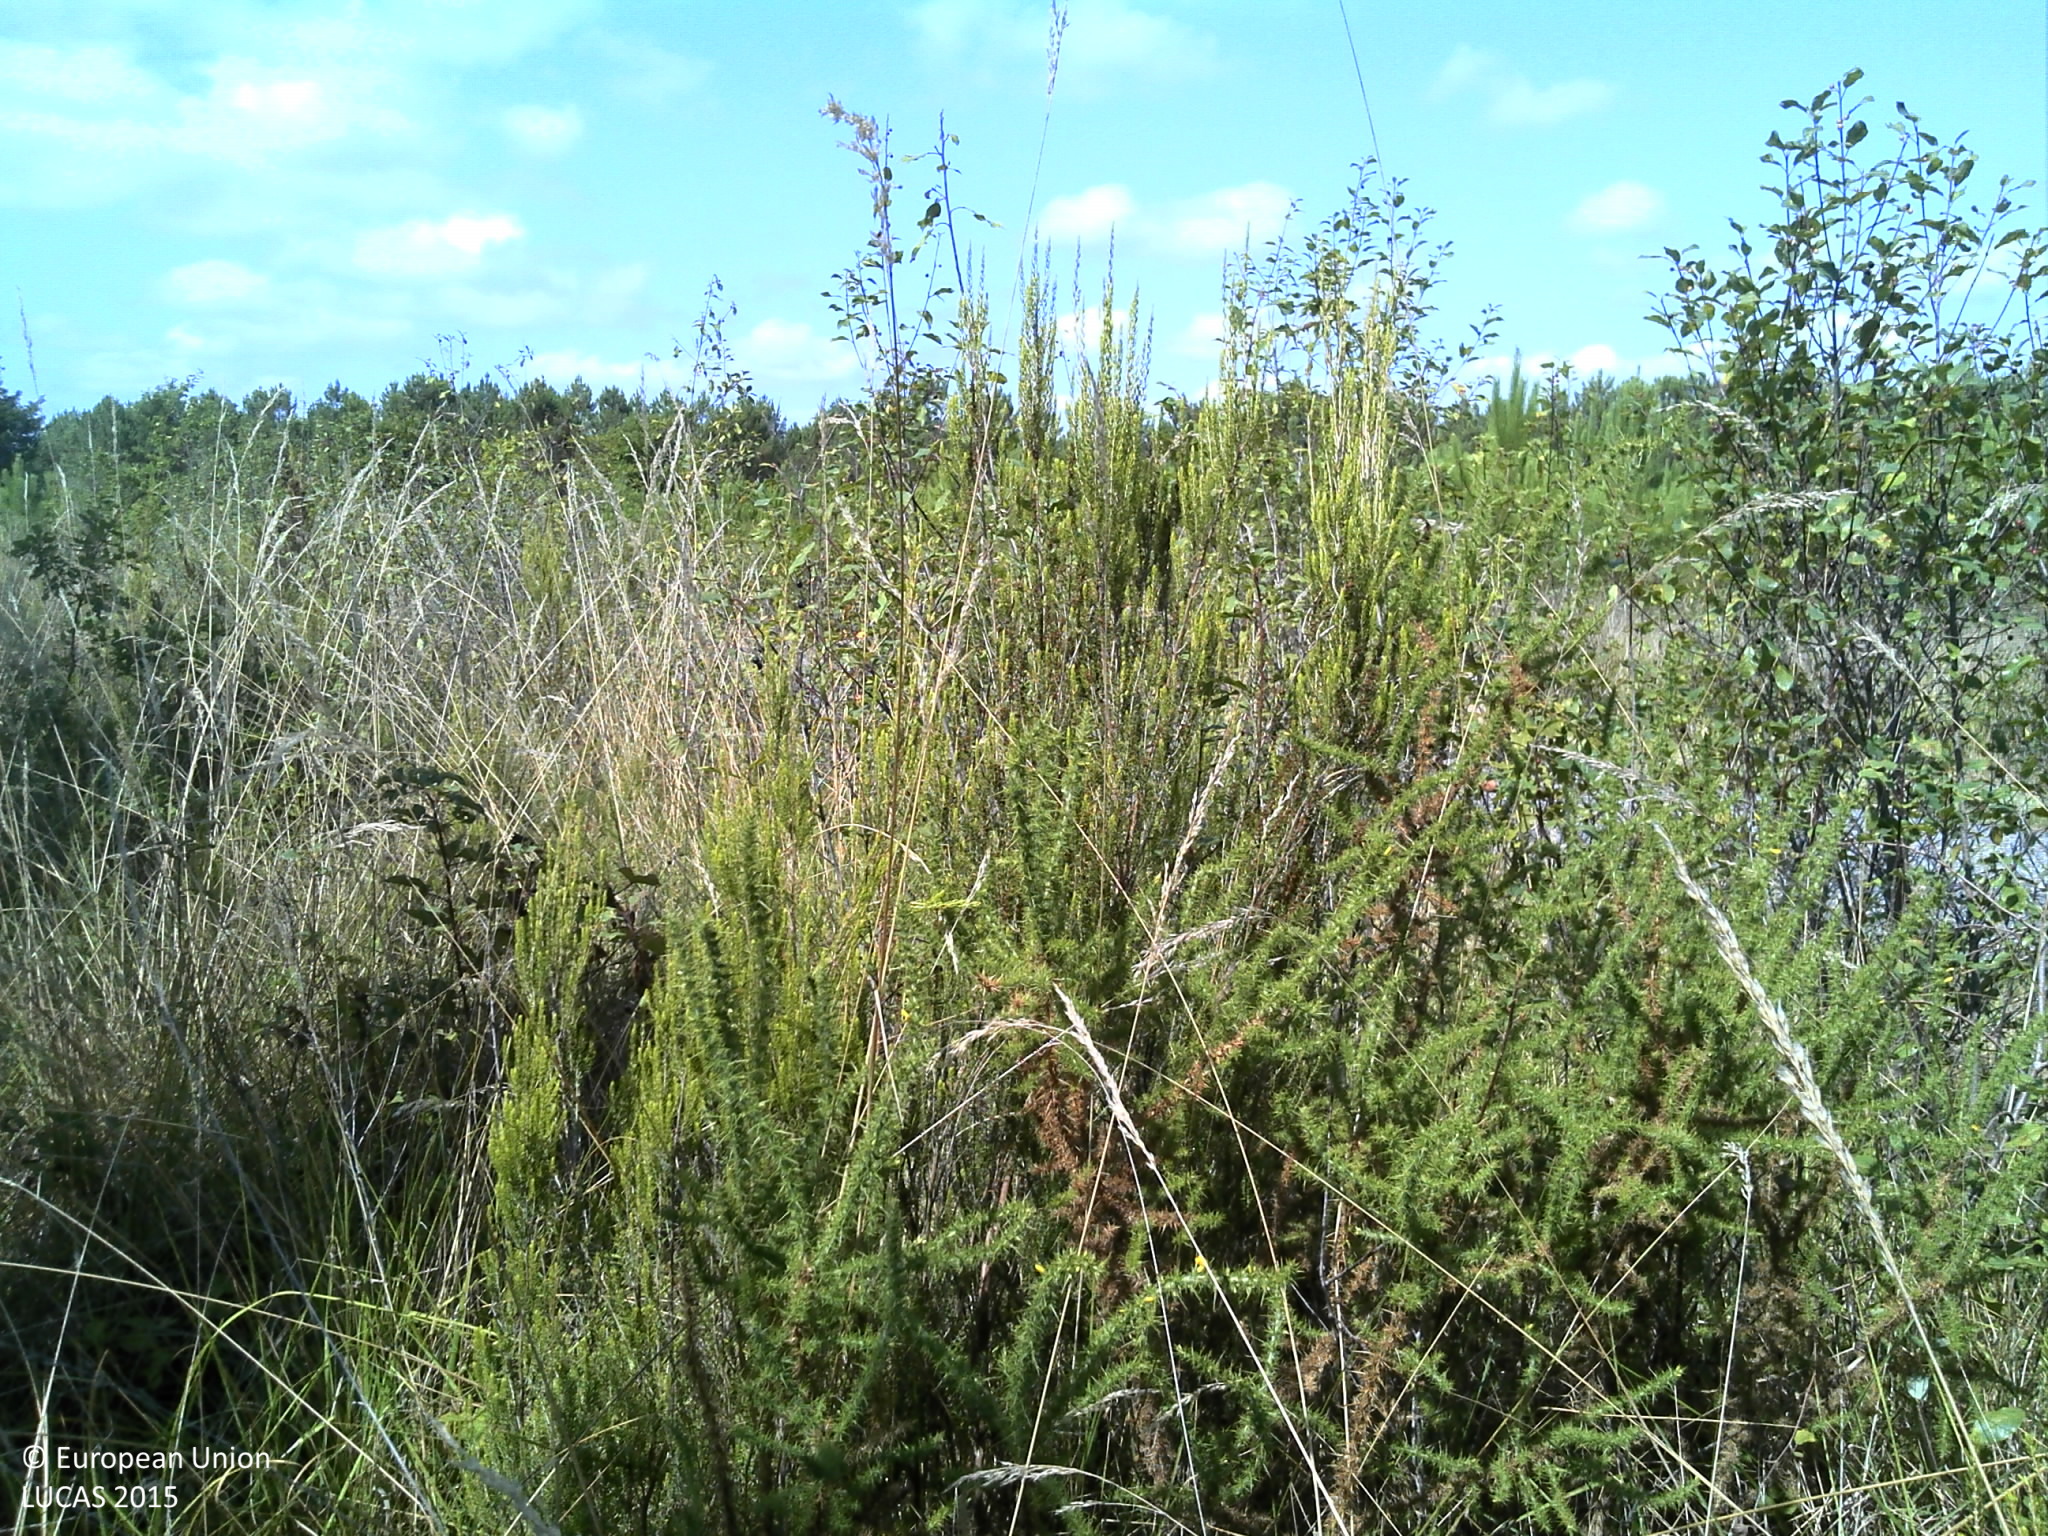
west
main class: Woodland
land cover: Pine dominated coniferous woodland
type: exotic forest
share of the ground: > 75 %
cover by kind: coniferous forest trees 60 %, shrubs 30 %, herbaceous plants 5 %, lichens and mosses 5 %
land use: Forestry
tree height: < 5 m
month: August
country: FR
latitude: 44.3905
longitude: -0.5733
